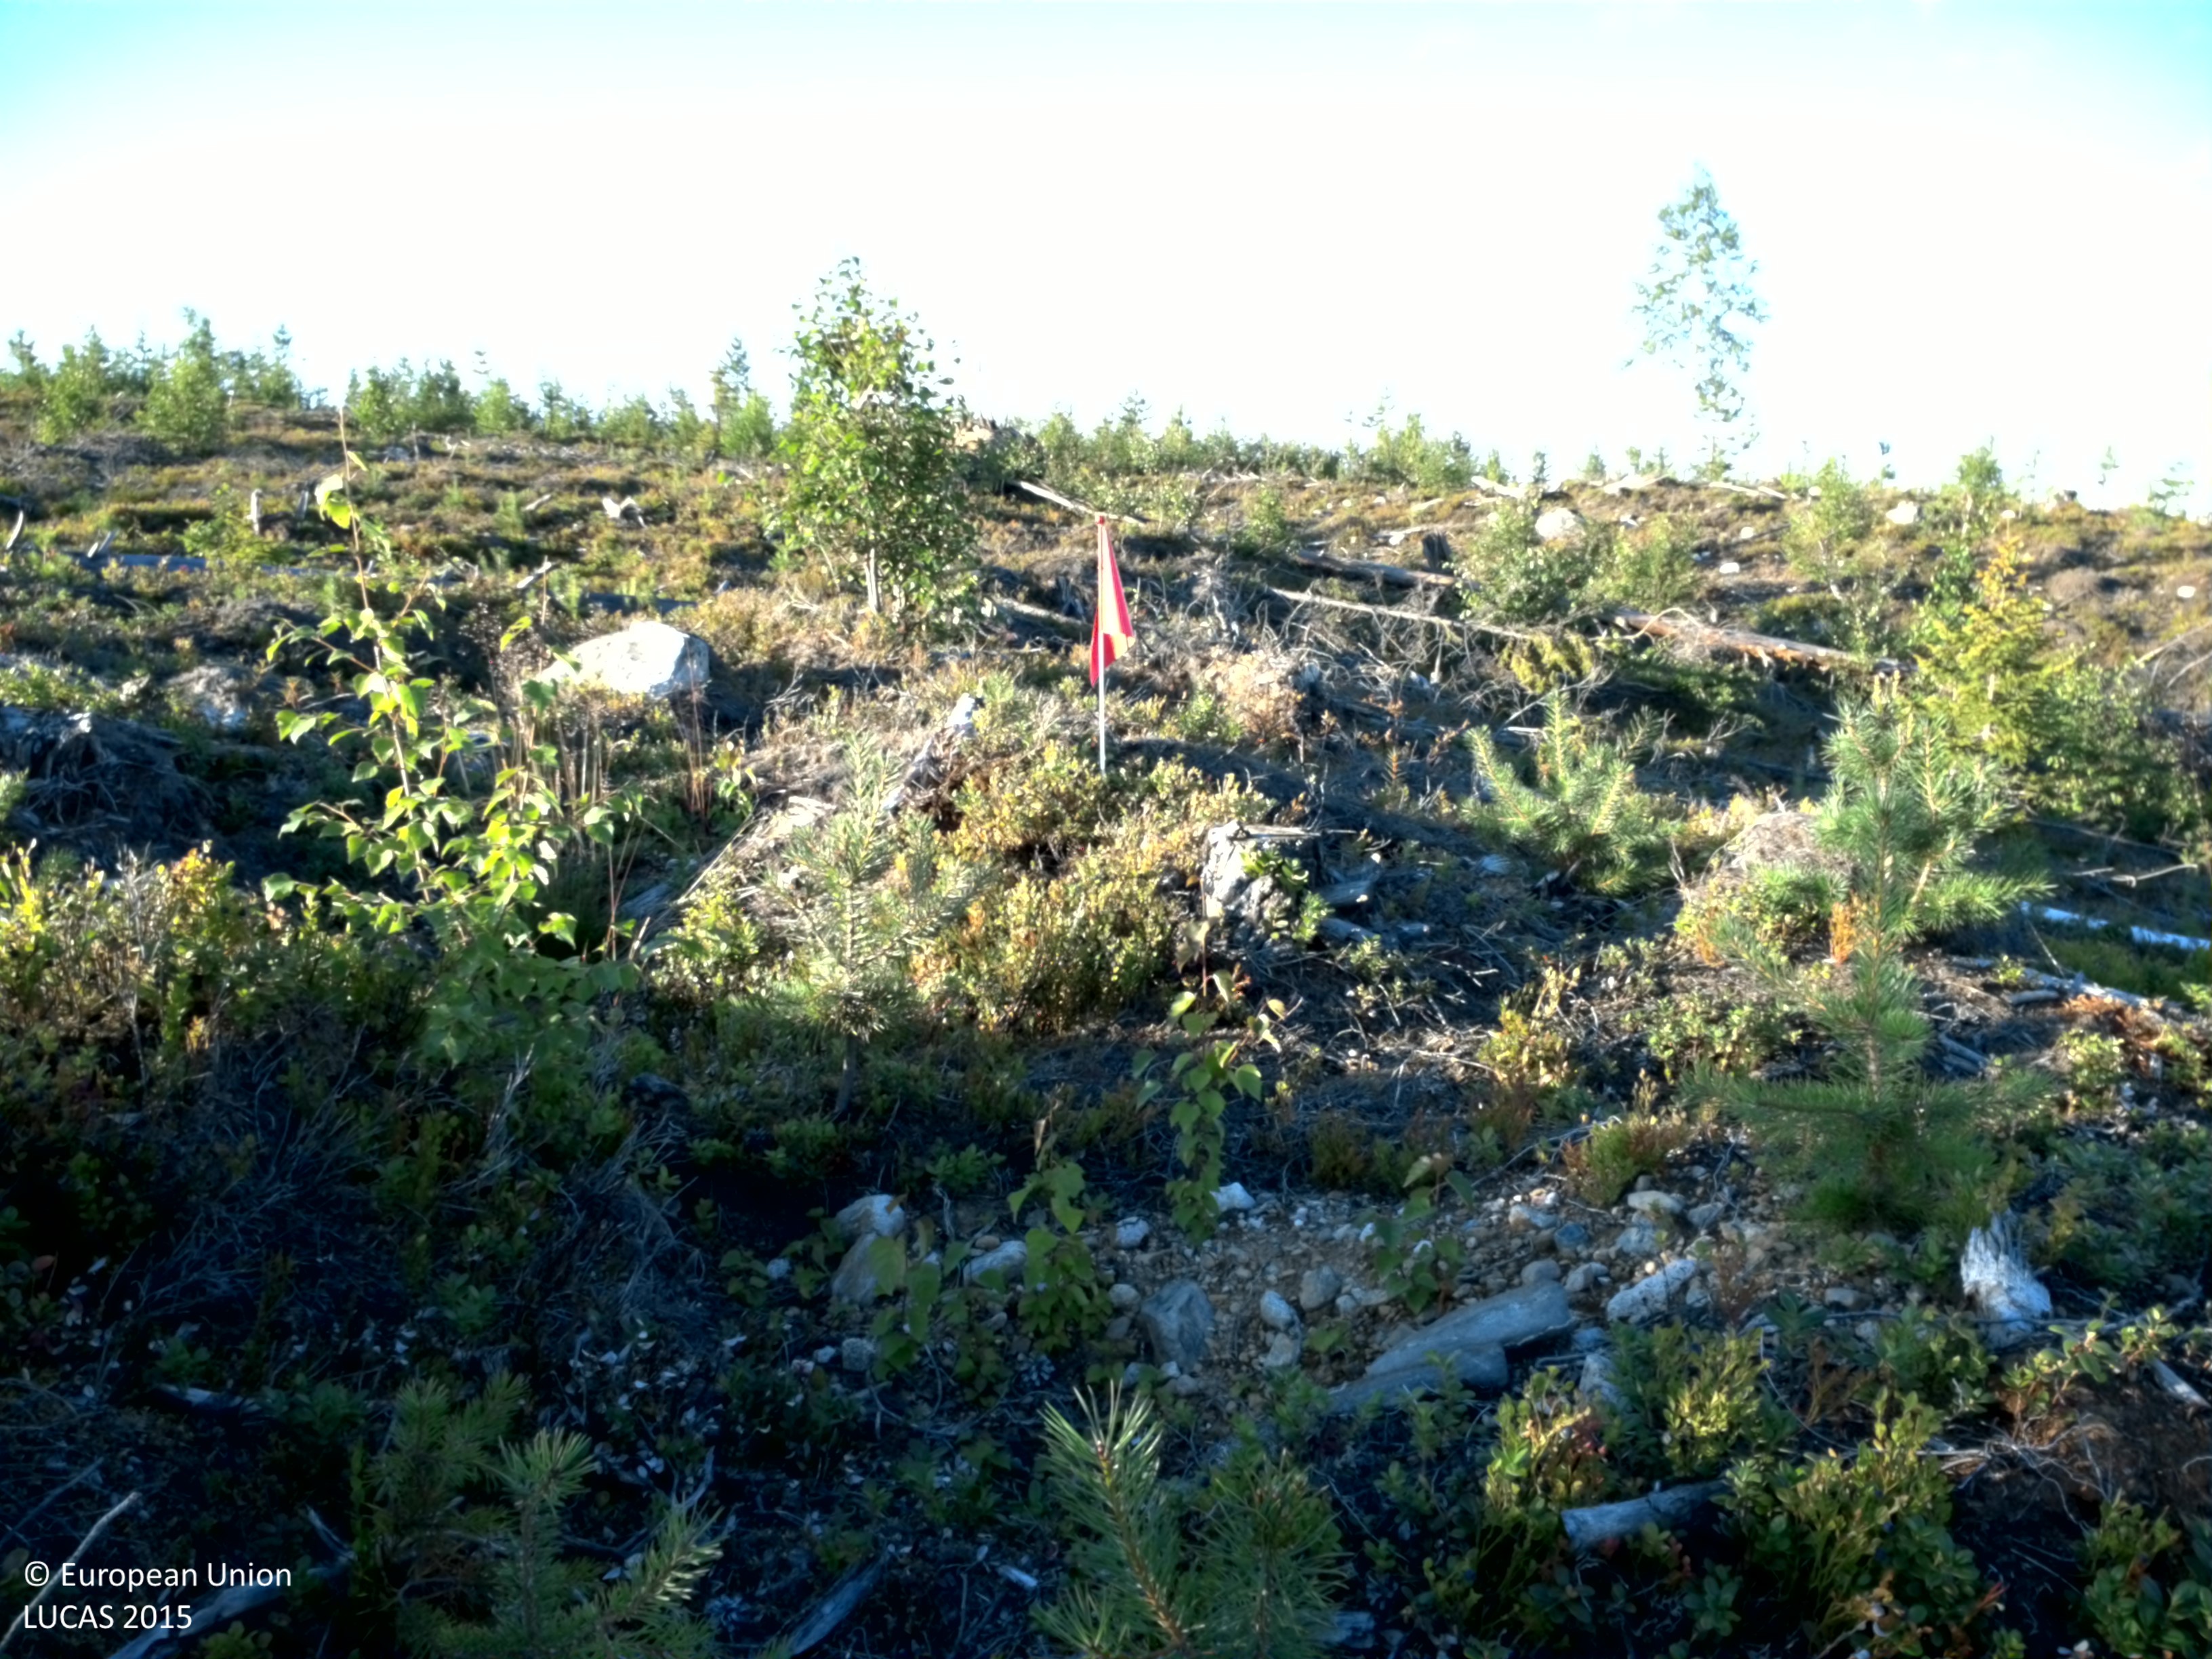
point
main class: Shrubland
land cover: Shrubland with sparse tree cover
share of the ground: > 75 %
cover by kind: shrubs 80 %, broadleaved forest trees 5 %, lichens and mosses 5 %, consolidated bare surface 5 %, unconsolidated bare surface 5 %
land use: Forestry
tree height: < 5 m
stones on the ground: 25 - 50 %
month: August
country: SE
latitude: 66.3590
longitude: 20.6632
